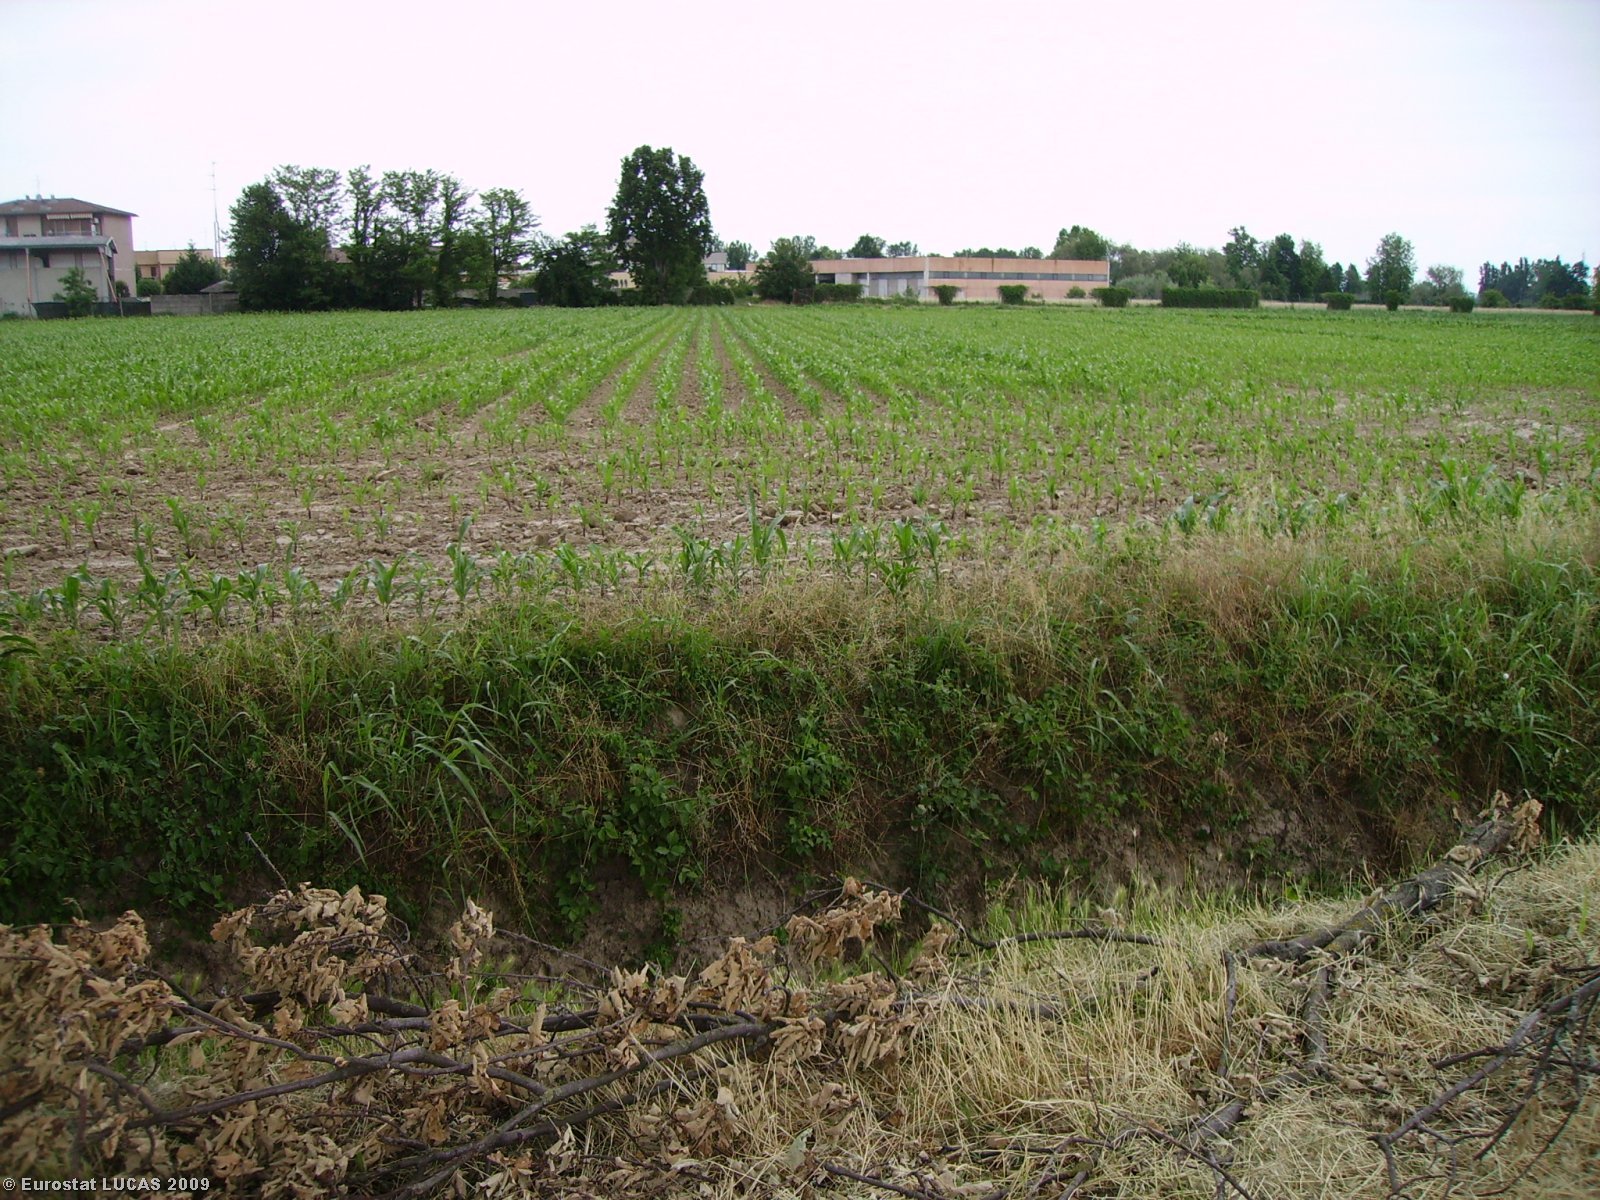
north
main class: Cropland
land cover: Maize
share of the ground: 25 - 50 %
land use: Agriculture (excluding fallow land and kitchen gardens)
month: May
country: IT
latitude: 45.2509
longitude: 9.5040
